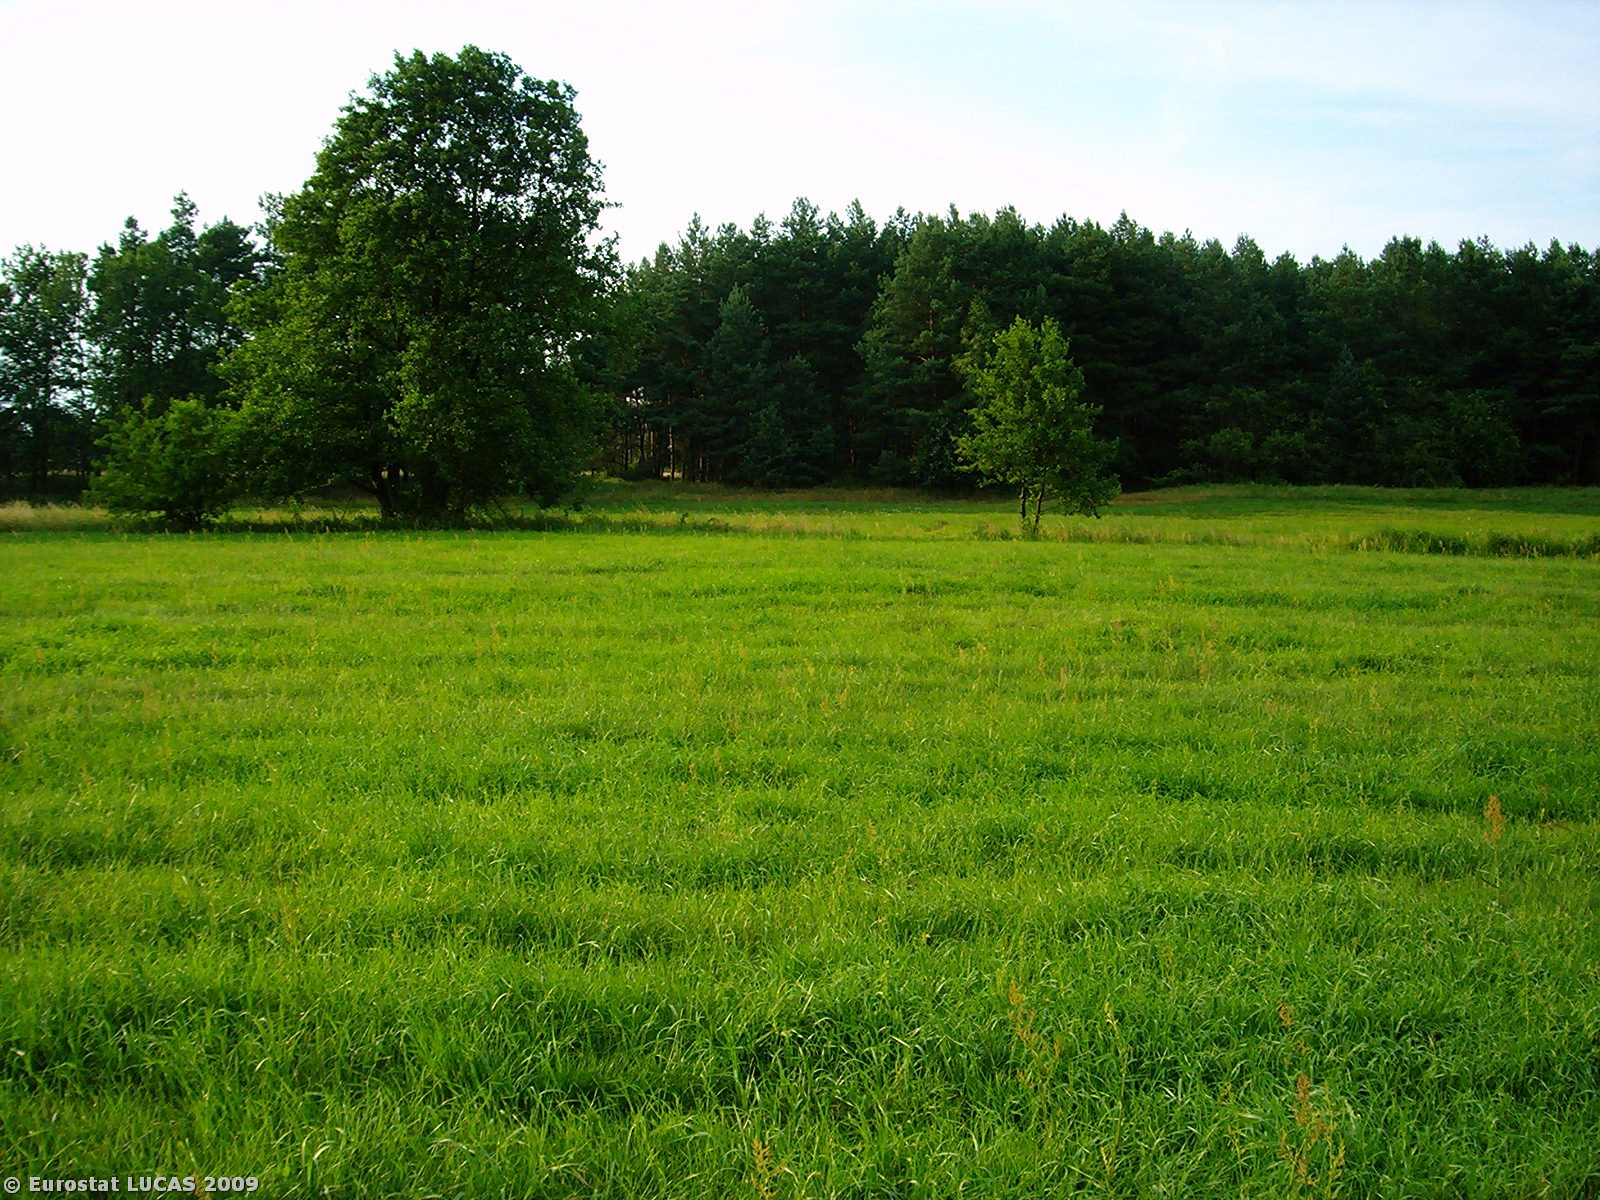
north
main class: Grassland
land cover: Grassland without tree/shrub cover
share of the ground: > 75 %
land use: Agriculture (excluding fallow land and kitchen gardens)
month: July
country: PL
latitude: 52.6166
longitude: 15.7501
